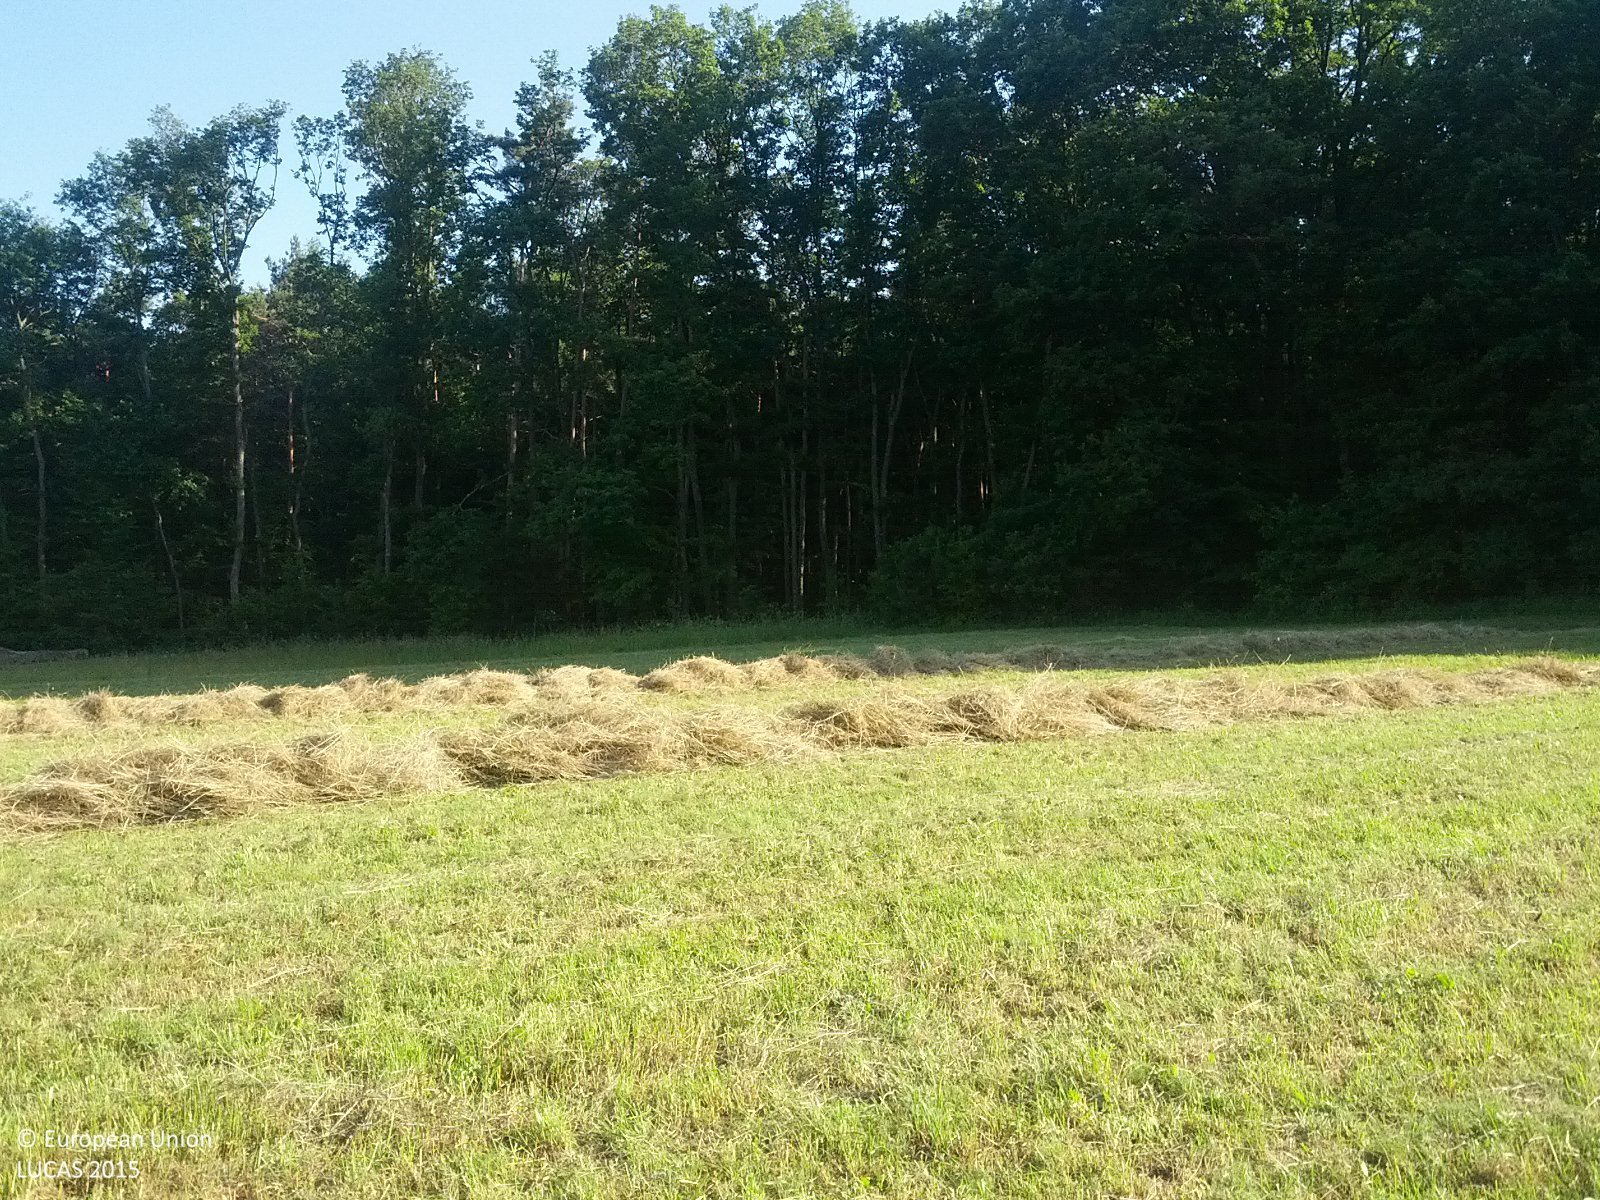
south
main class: Grassland
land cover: Grassland without tree/shrub cover
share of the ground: > 75 %
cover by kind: herbaceous plants 100 %
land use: Agriculture (excluding fallow land and kitchen gardens)
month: June
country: AT
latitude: 47.1888
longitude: 16.4035
